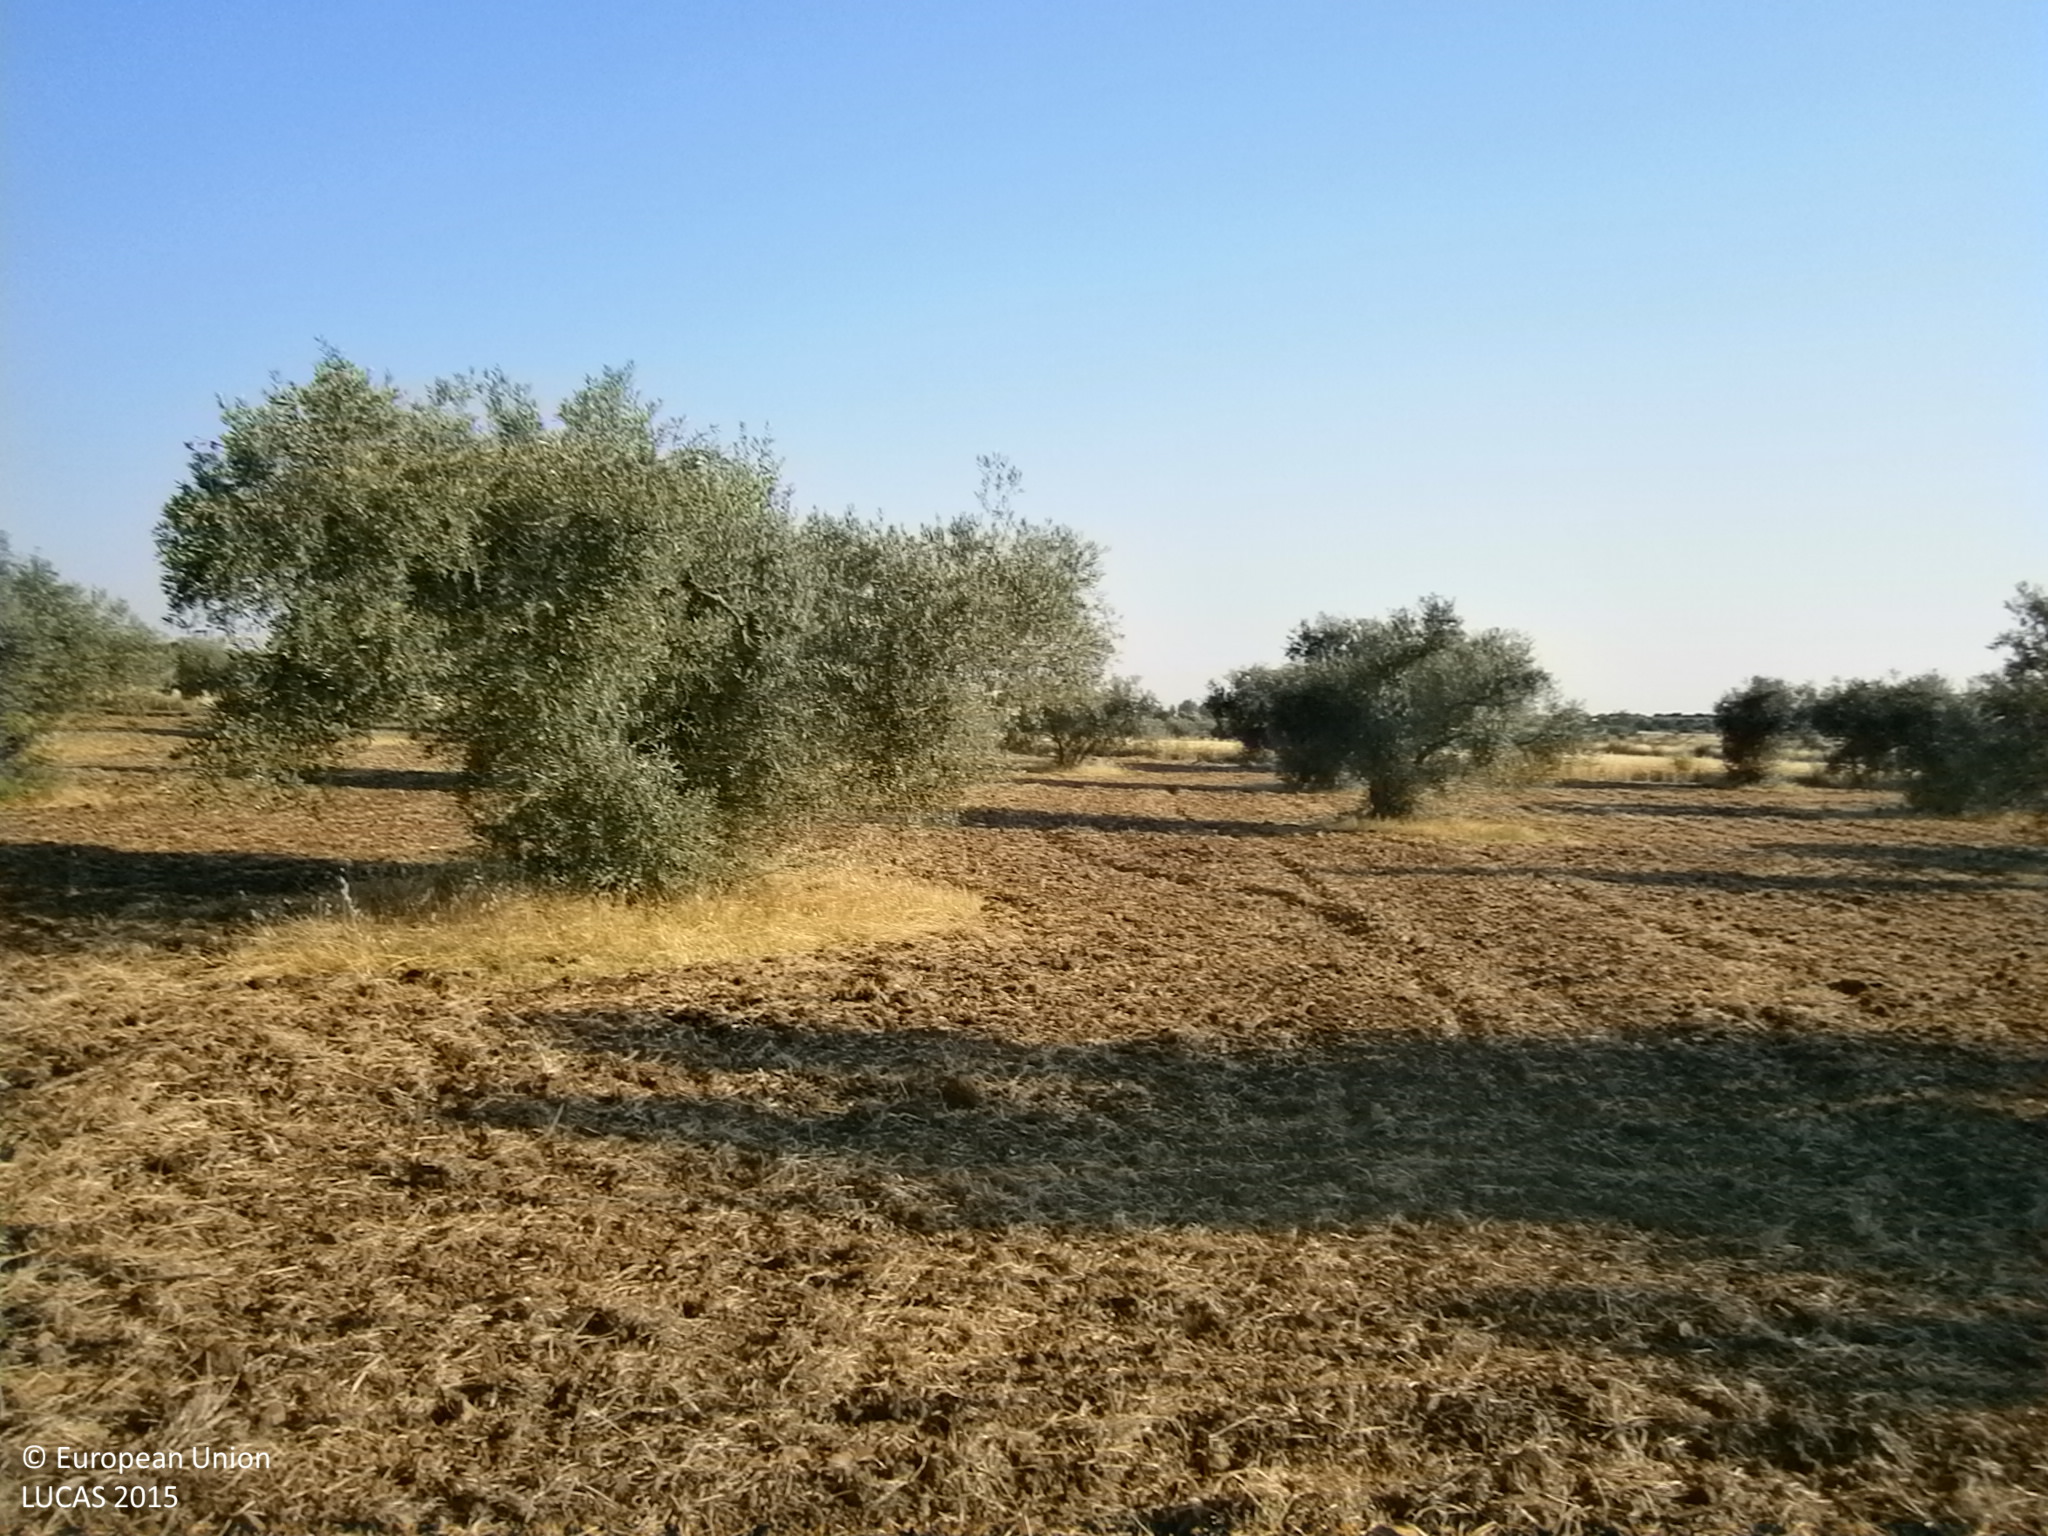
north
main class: Cropland
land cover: Olive groves
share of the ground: 25 - 50 %
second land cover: Other bare soil
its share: > 75 %
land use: Agriculture (excluding fallow land and kitchen gardens)
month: June
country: ES
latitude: 38.6055
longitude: -6.7920
